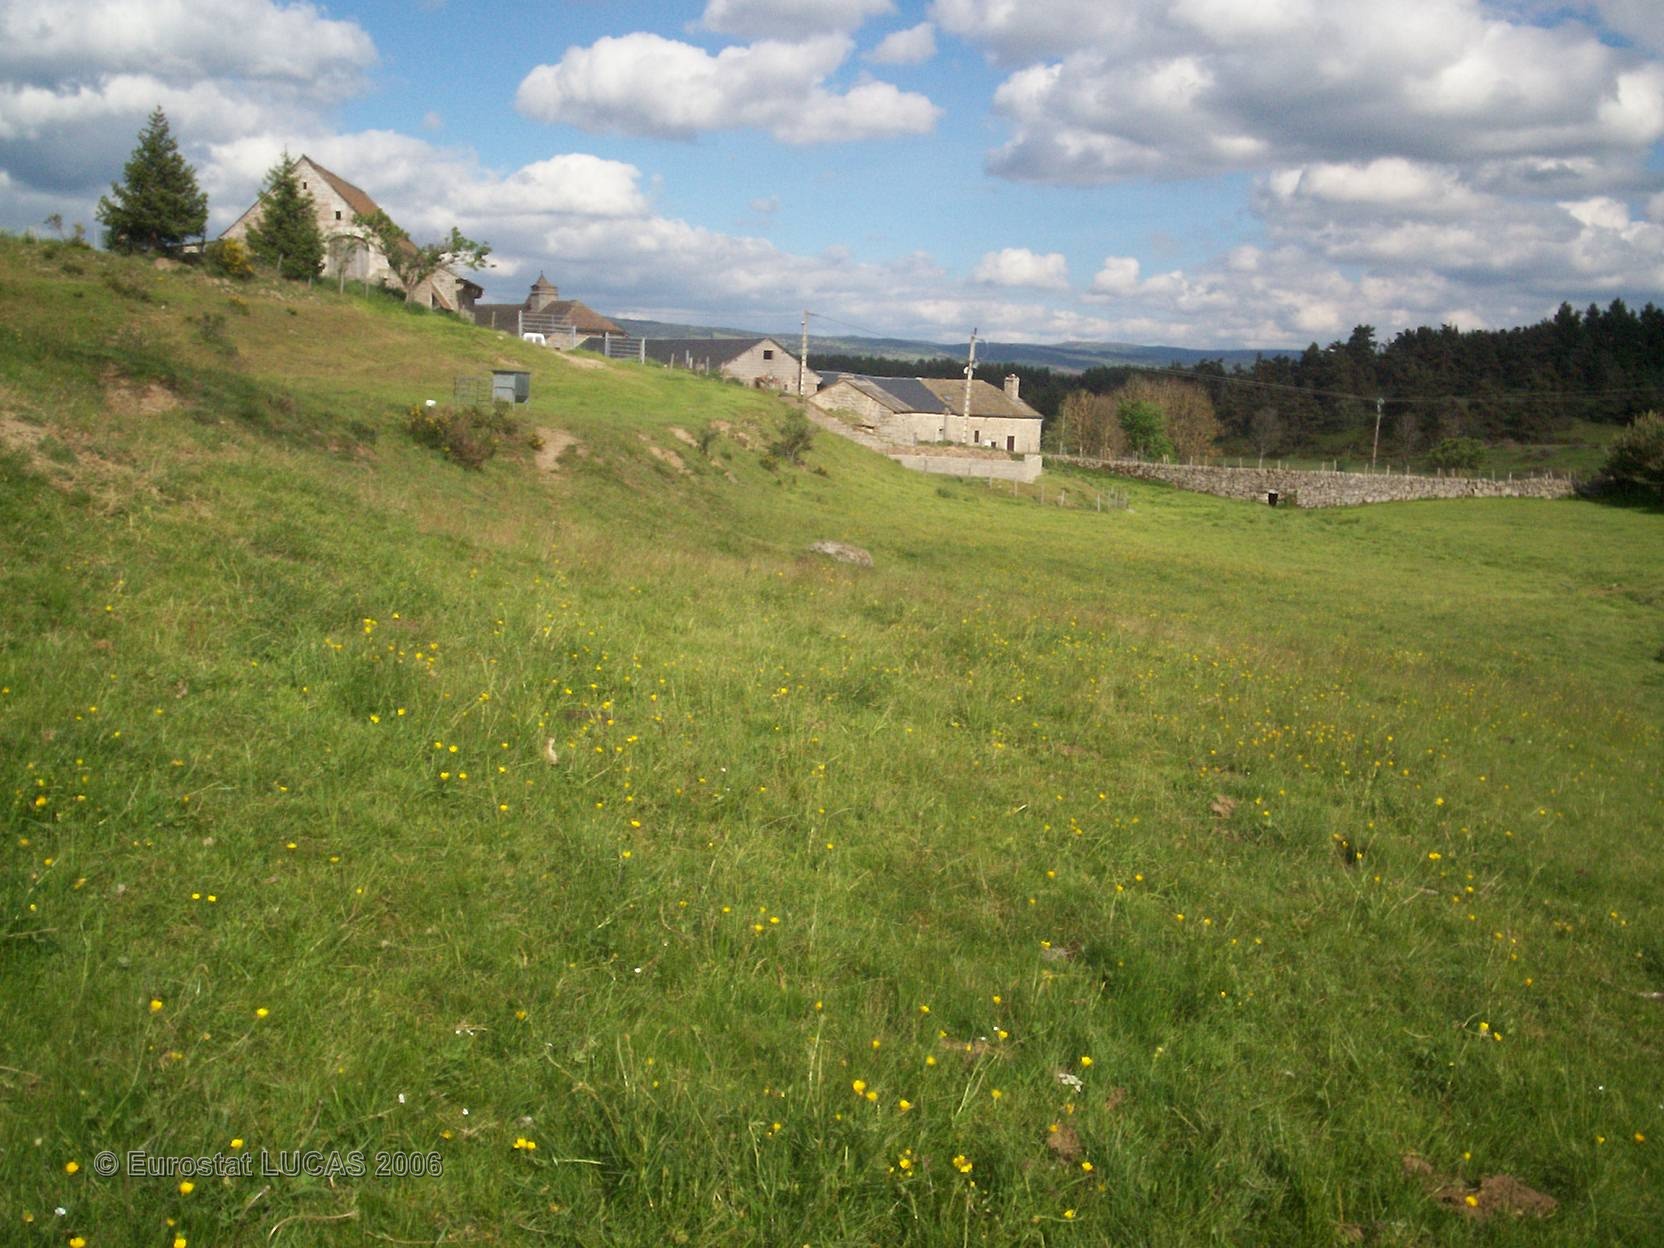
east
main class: Grassland
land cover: Grassland with sparse tree/shrub cover
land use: Agriculture (excluding fallow land and kitchen gardens)
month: May
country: FR
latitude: 44.7177
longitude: 3.3766
